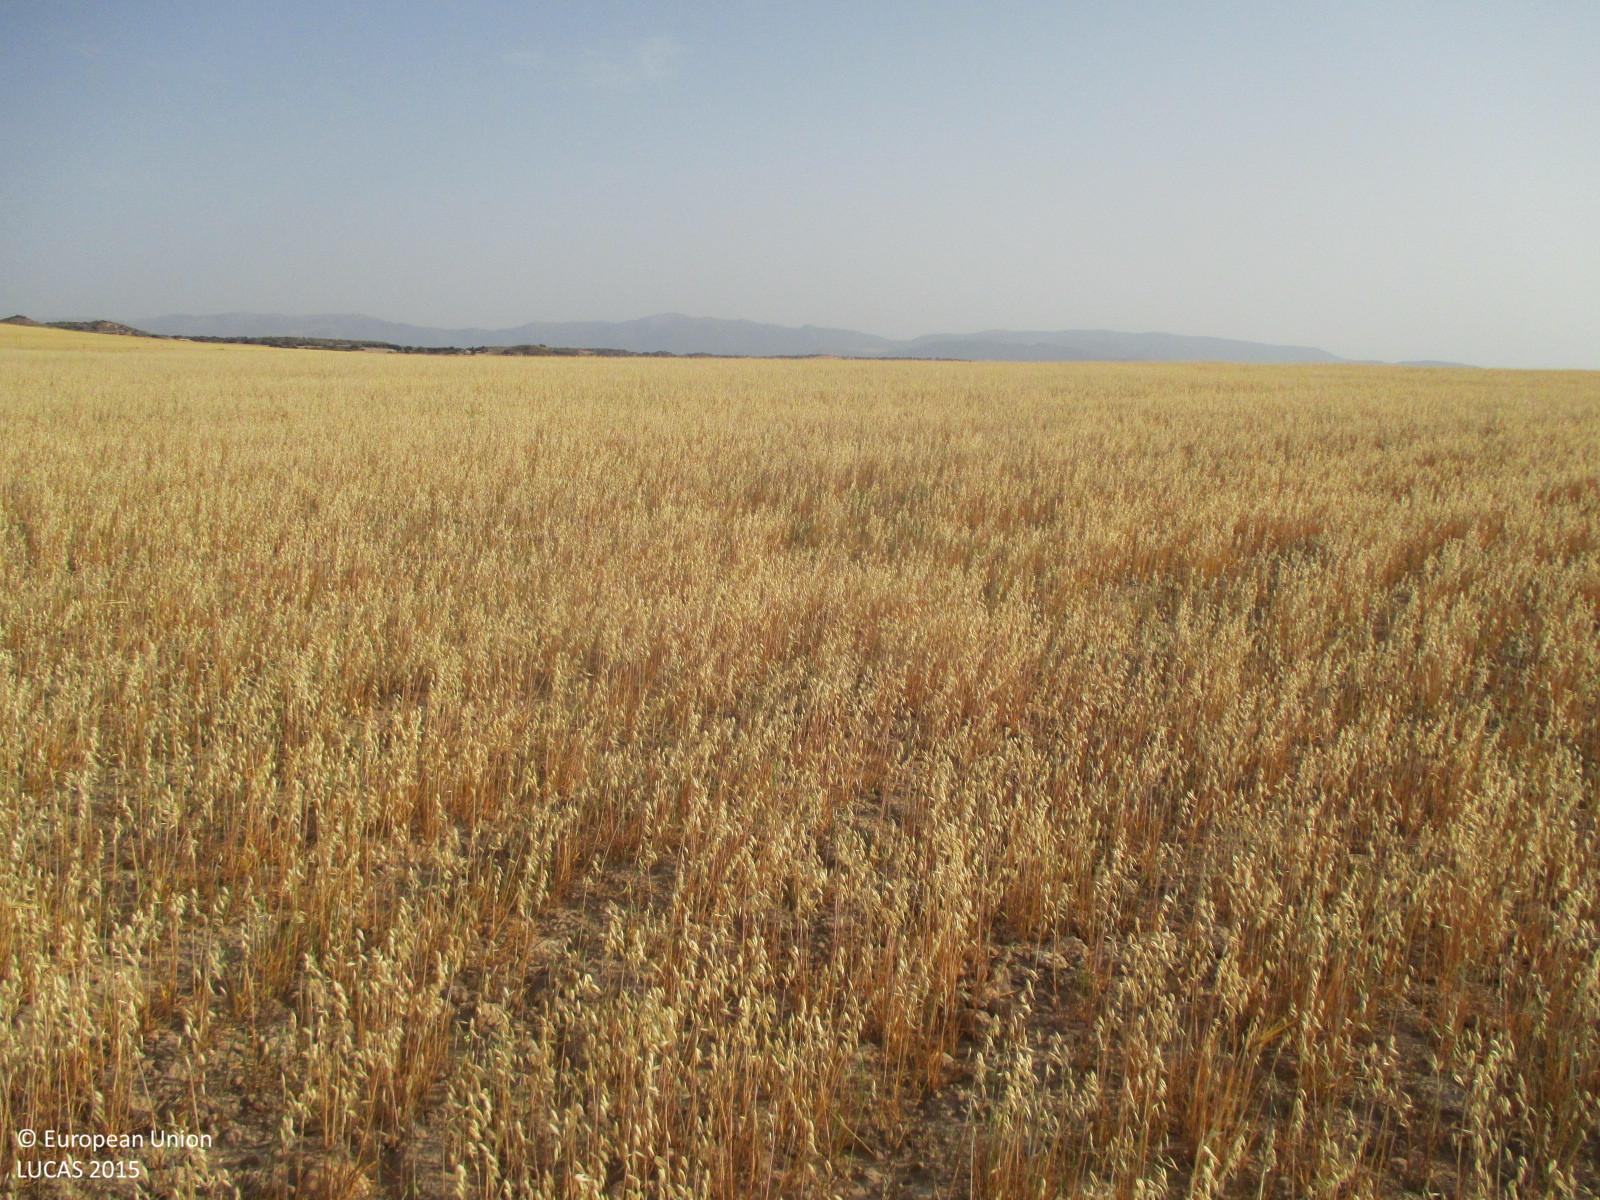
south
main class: Cropland
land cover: Oats
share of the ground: 25 - 50 %
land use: Agriculture (excluding fallow land and kitchen gardens)
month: July
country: ES
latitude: 37.8353
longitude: -2.3628
